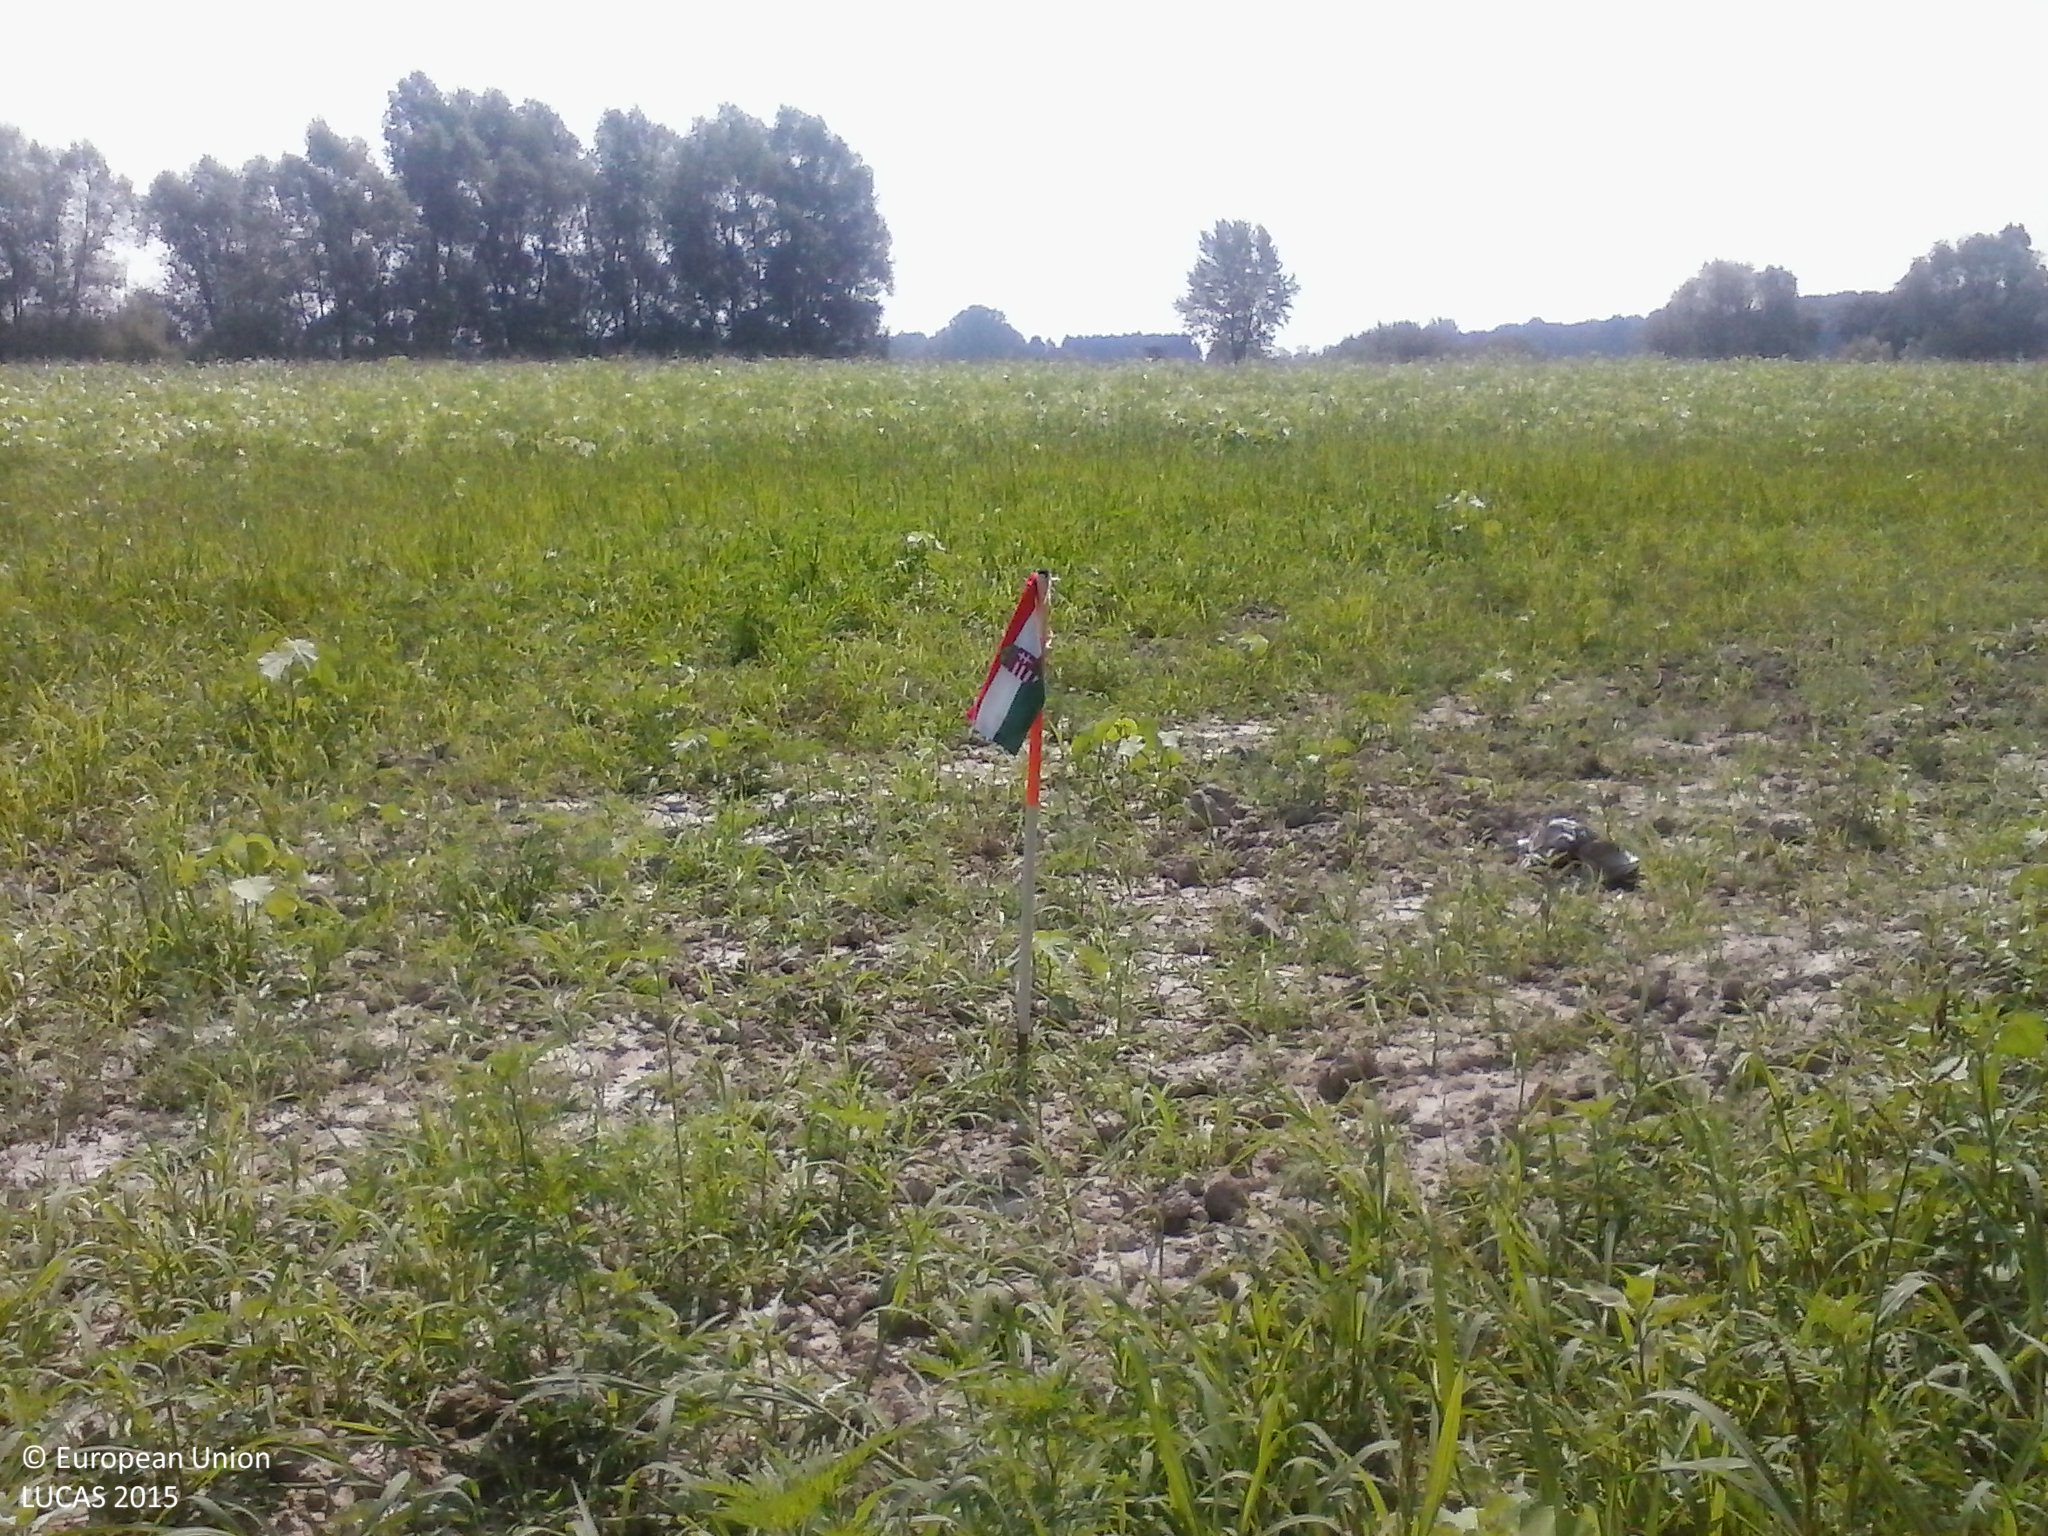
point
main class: Grassland
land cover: Spontaneously vegetated surfaces
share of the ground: > 75 %
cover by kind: herbaceous plants 80 %, unconsolidated bare surface 20 %
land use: Fallow land
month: August
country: HU
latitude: 45.8673
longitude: 17.7976
